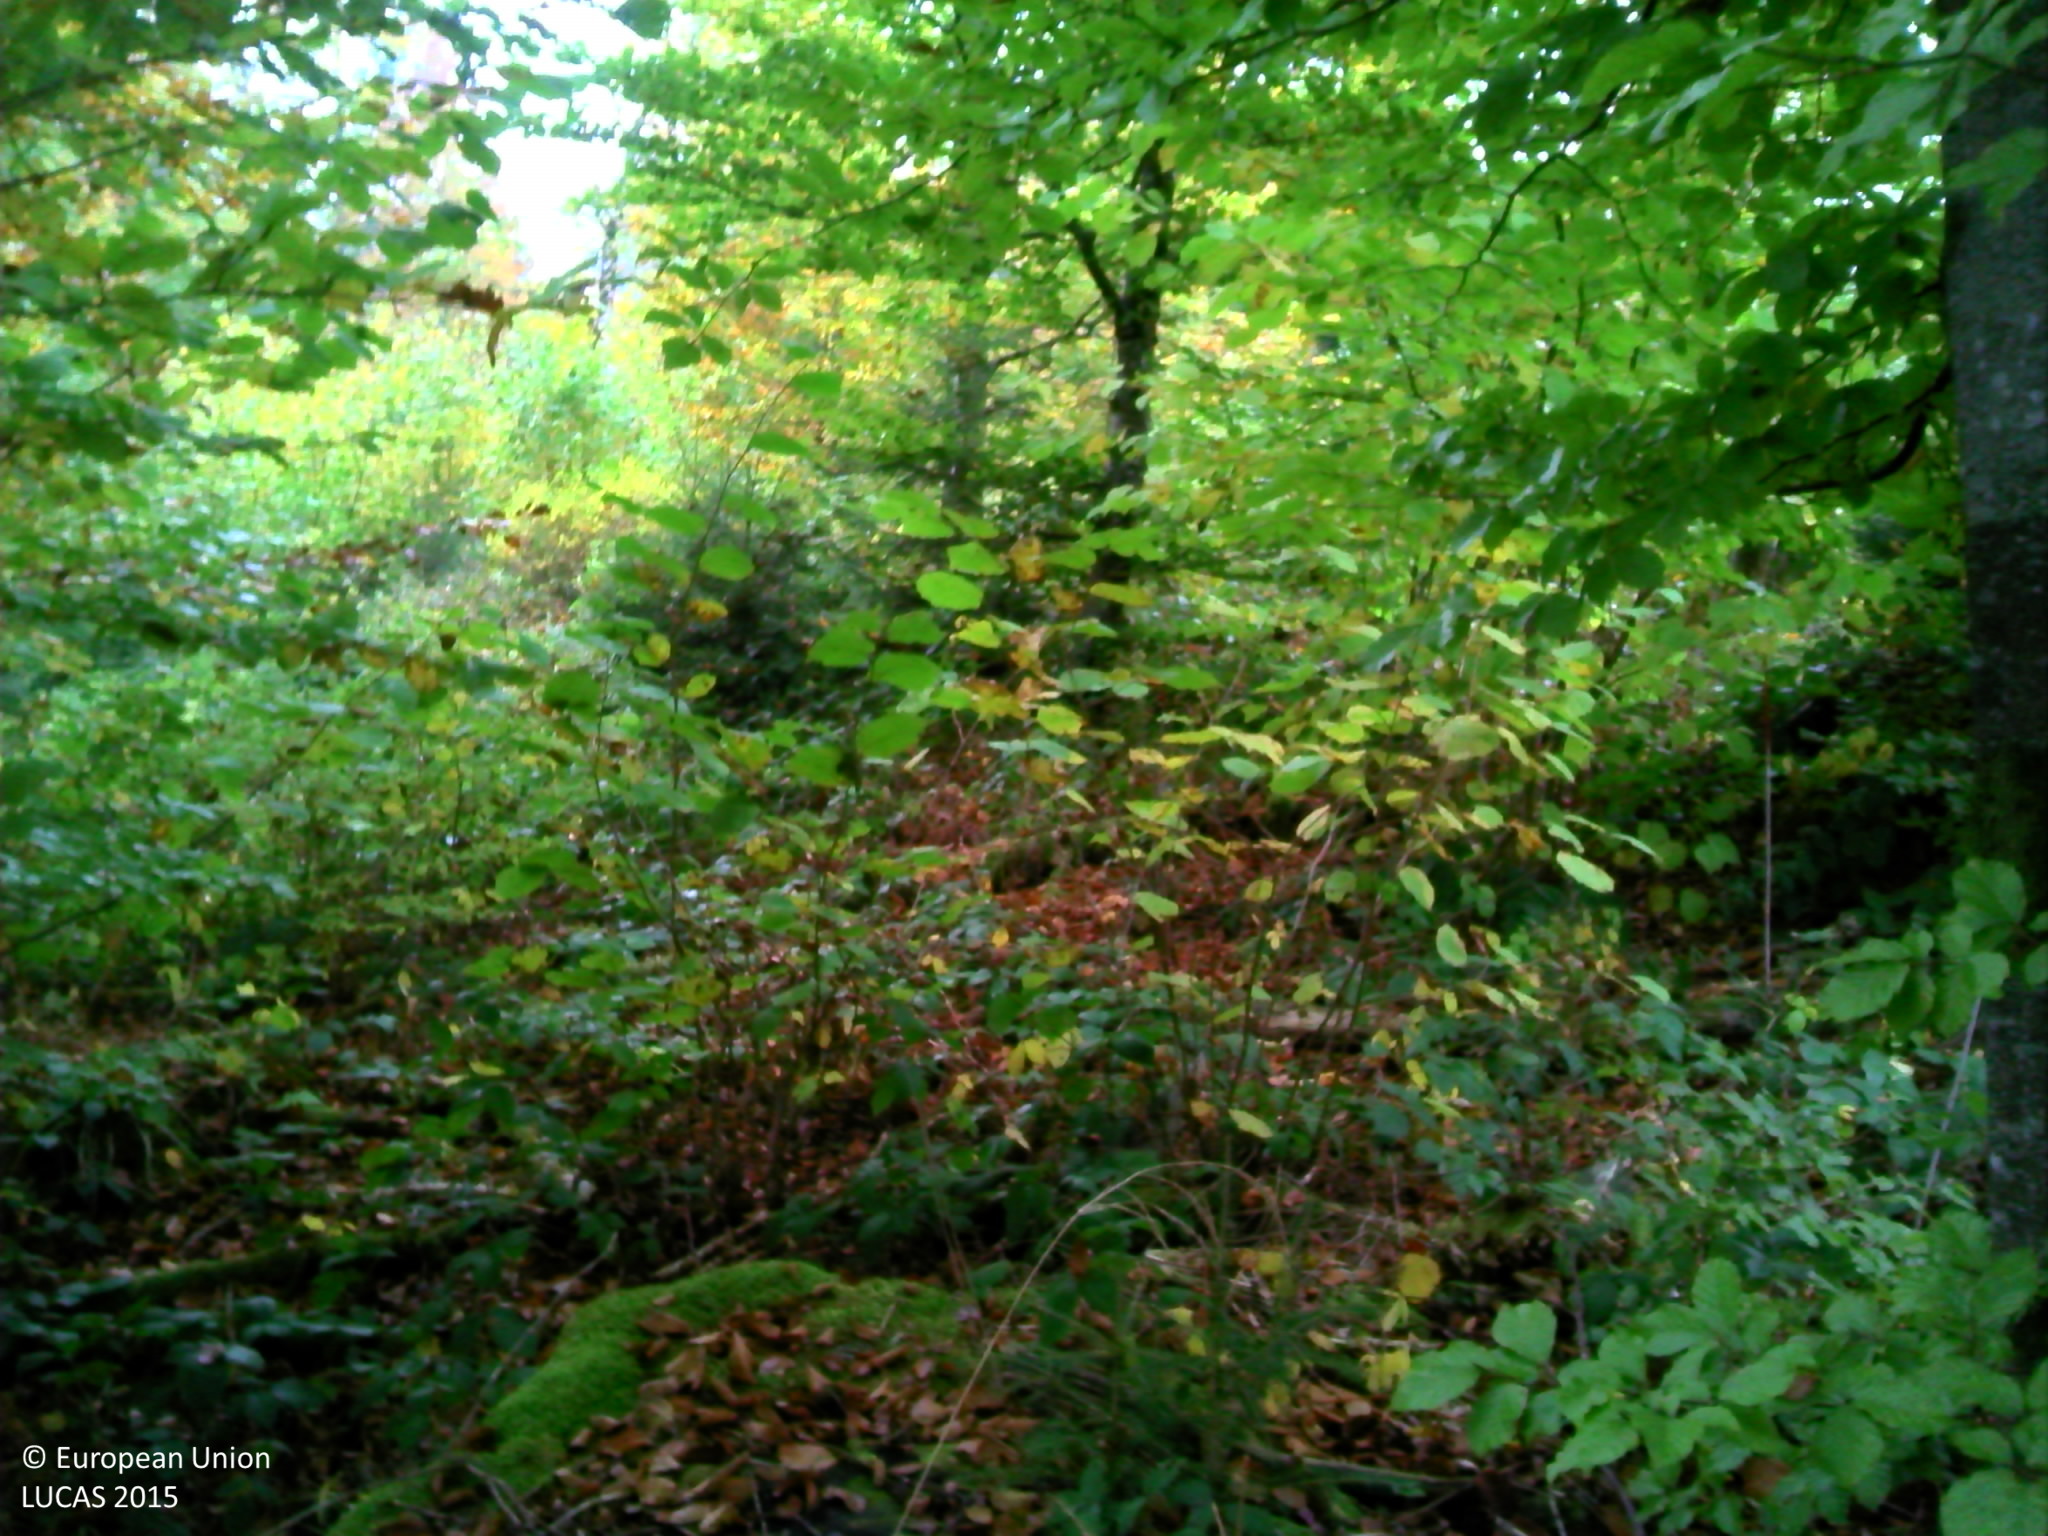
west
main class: Woodland
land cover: Spruce dominated mixed woodland
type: mountainous beech forest
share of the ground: > 75 %
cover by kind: broadleaved forest trees 60 %, coniferous forest trees 30 %, shrubs 5 %, unconsolidated bare surface 5 %
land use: Forestry
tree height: > 5 m
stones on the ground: < 10 %
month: October
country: FR
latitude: 46.8942
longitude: 6.1304
